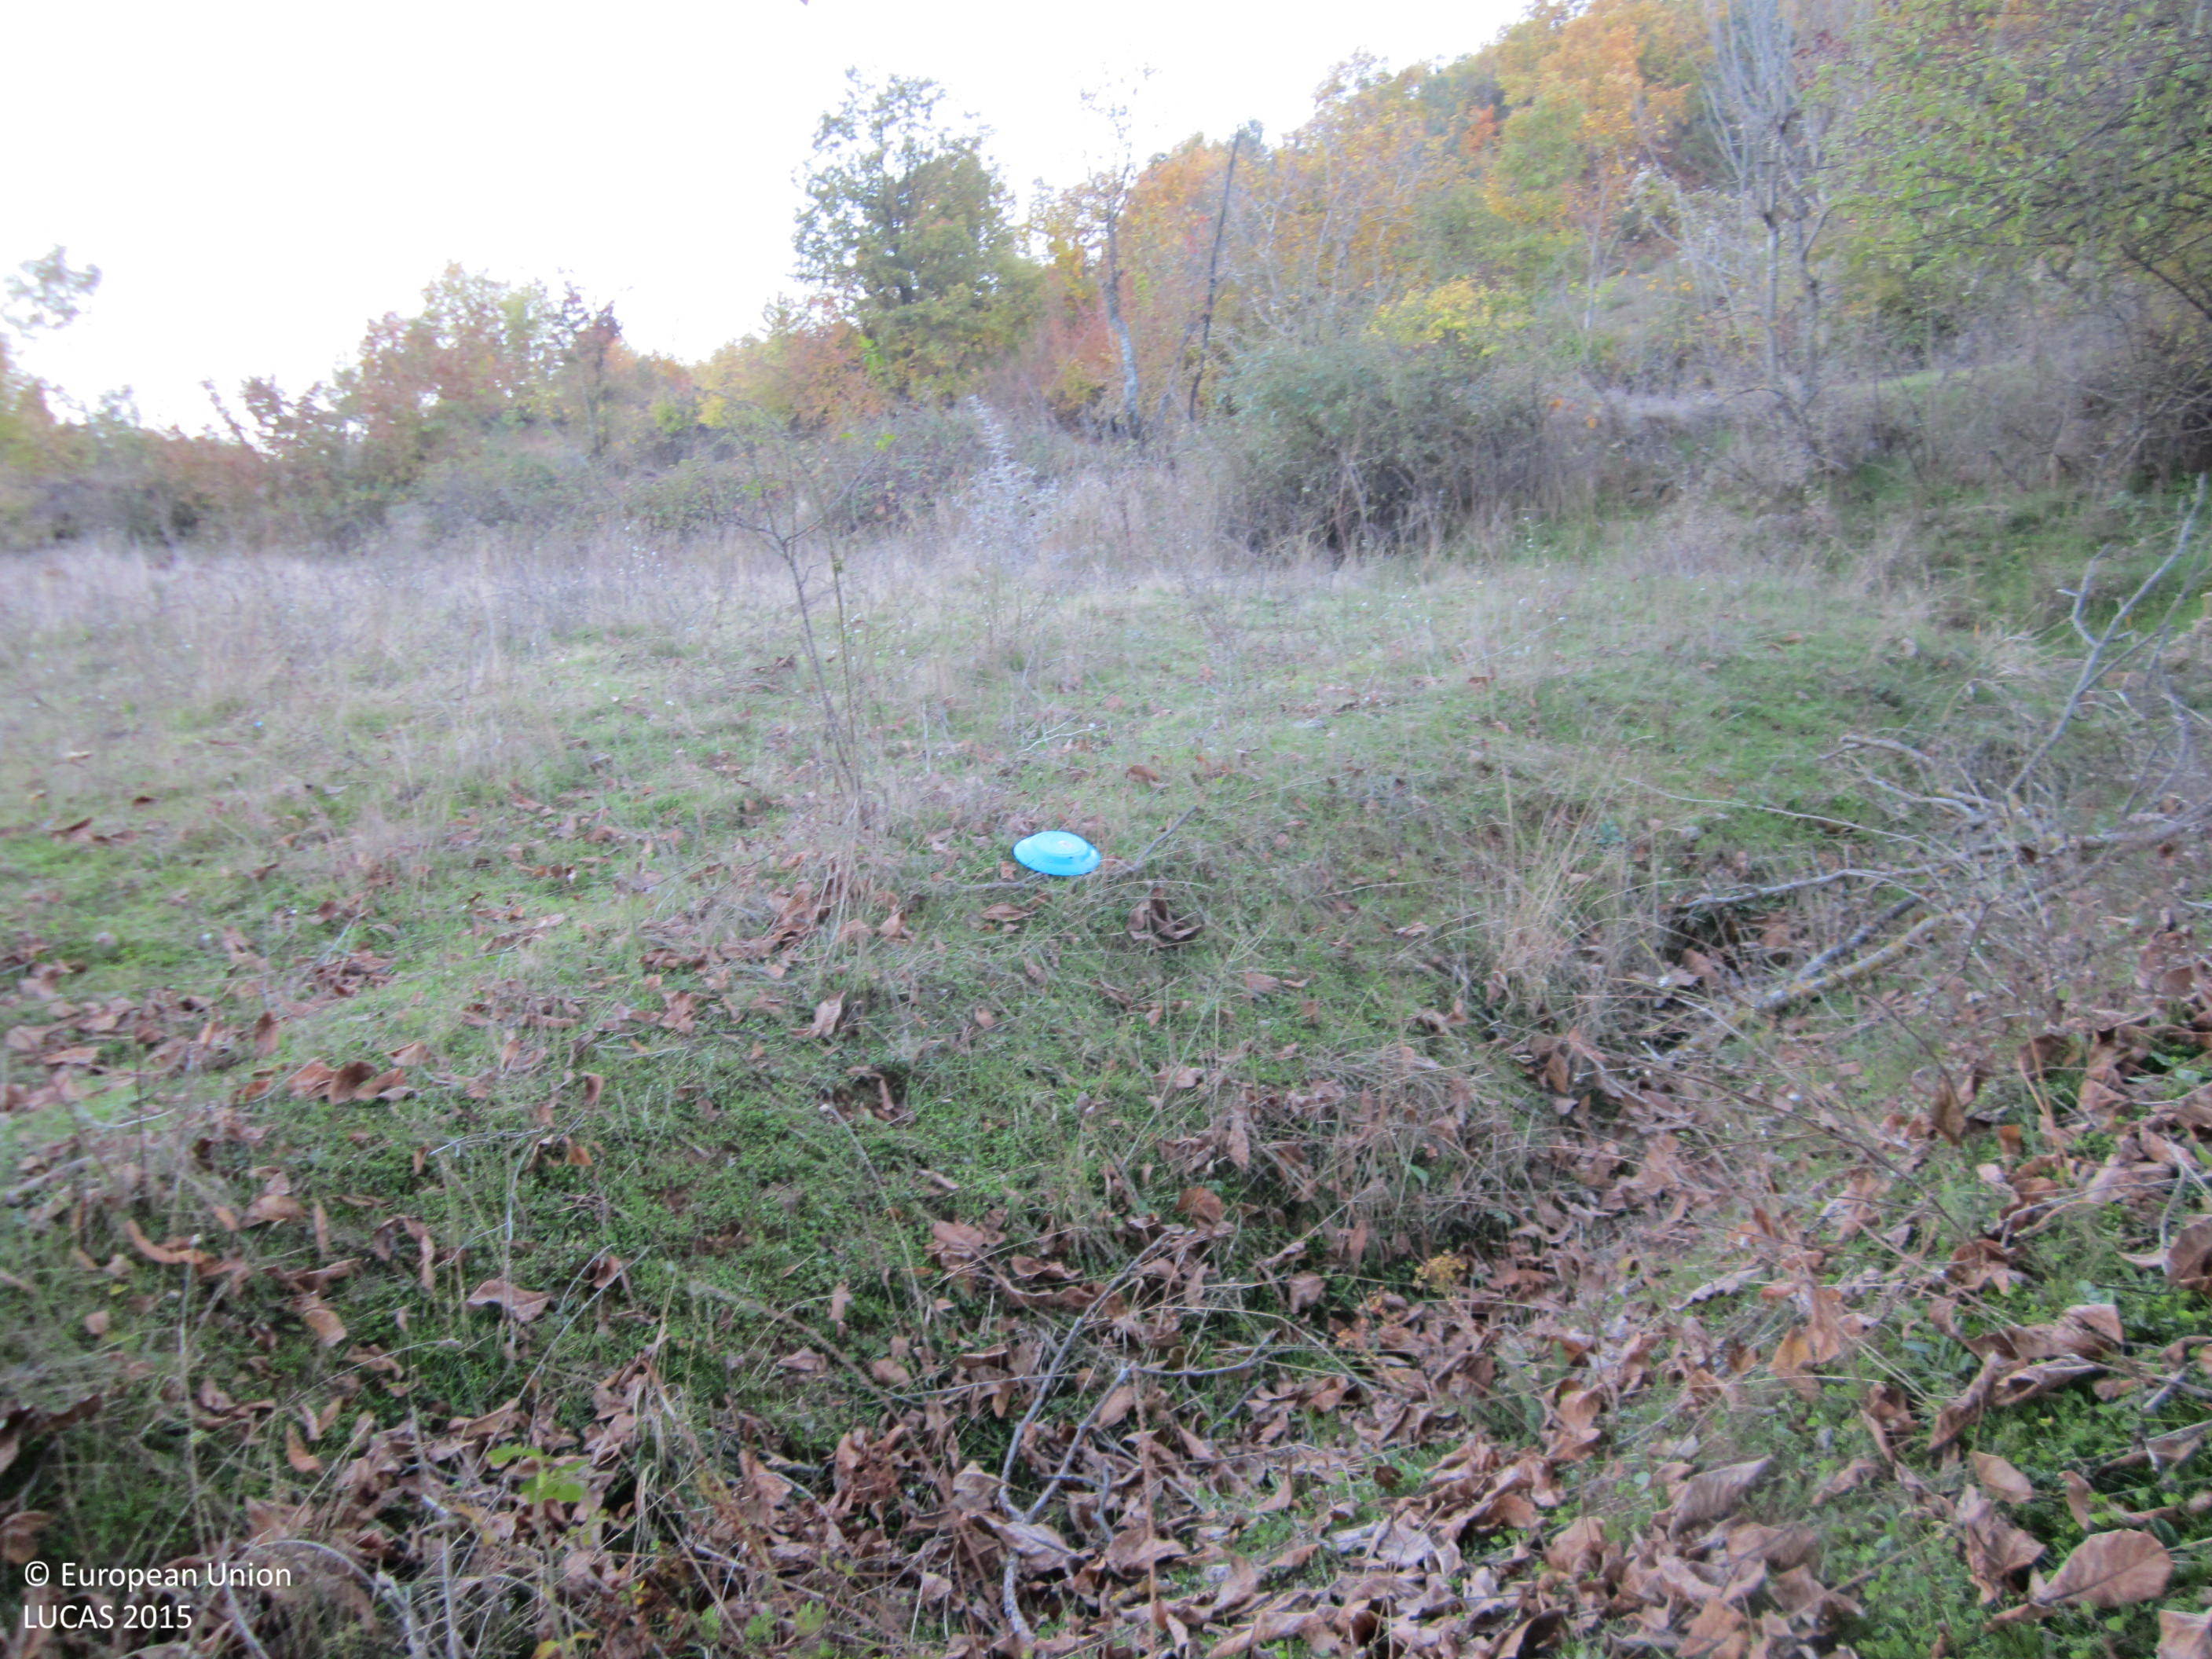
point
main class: Grassland
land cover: Grassland with sparse tree/shrub cover
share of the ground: > 75 %
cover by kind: herbaceous plants 90 %, broadleaved forest trees 5 %, shrubs 5 %
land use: Agriculture (excluding fallow land and kitchen gardens)
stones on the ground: < 10 %
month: November
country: BG
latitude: 41.4108
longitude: 25.6471
